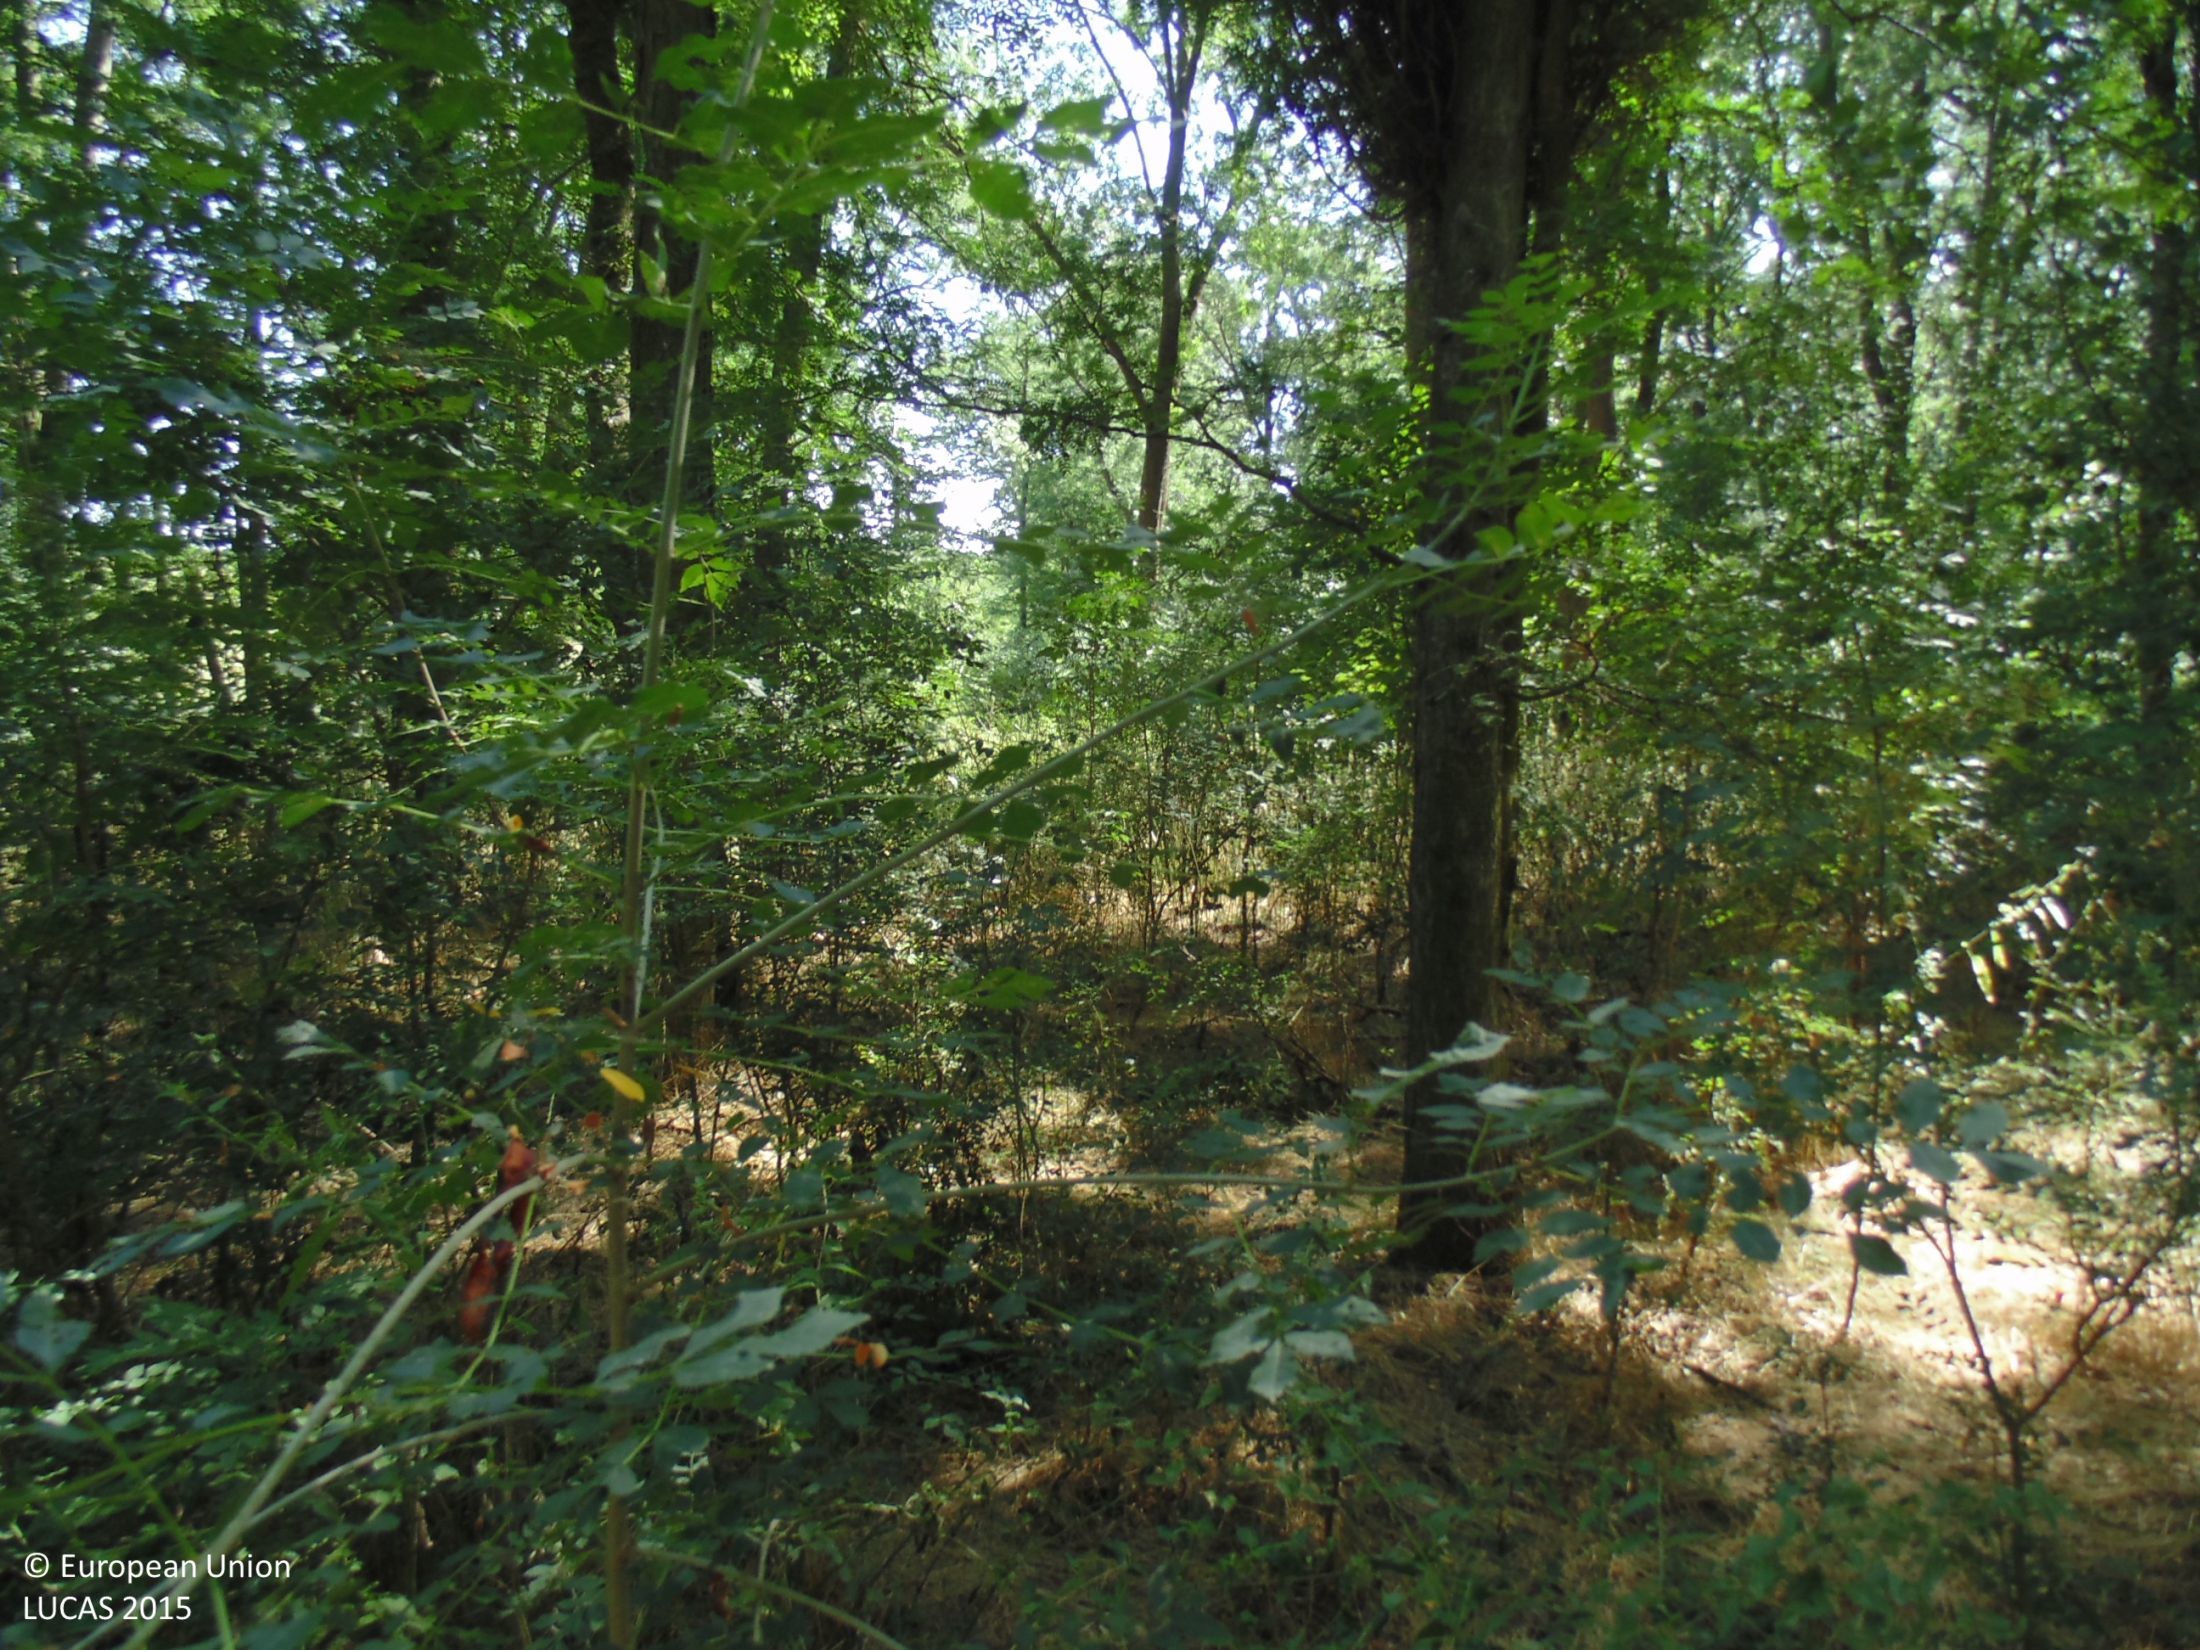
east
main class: Woodland
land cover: Broadleaved woodland
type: mesophytic deciduous forest
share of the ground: > 75 %
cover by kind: broadleaved forest trees 85 %, herbaceous plants 10 %, shrubs 5 %
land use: Forestry
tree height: > 5 m
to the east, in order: Broadleaved woodland
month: August
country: BG
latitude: 43.6266
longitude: 28.2108
